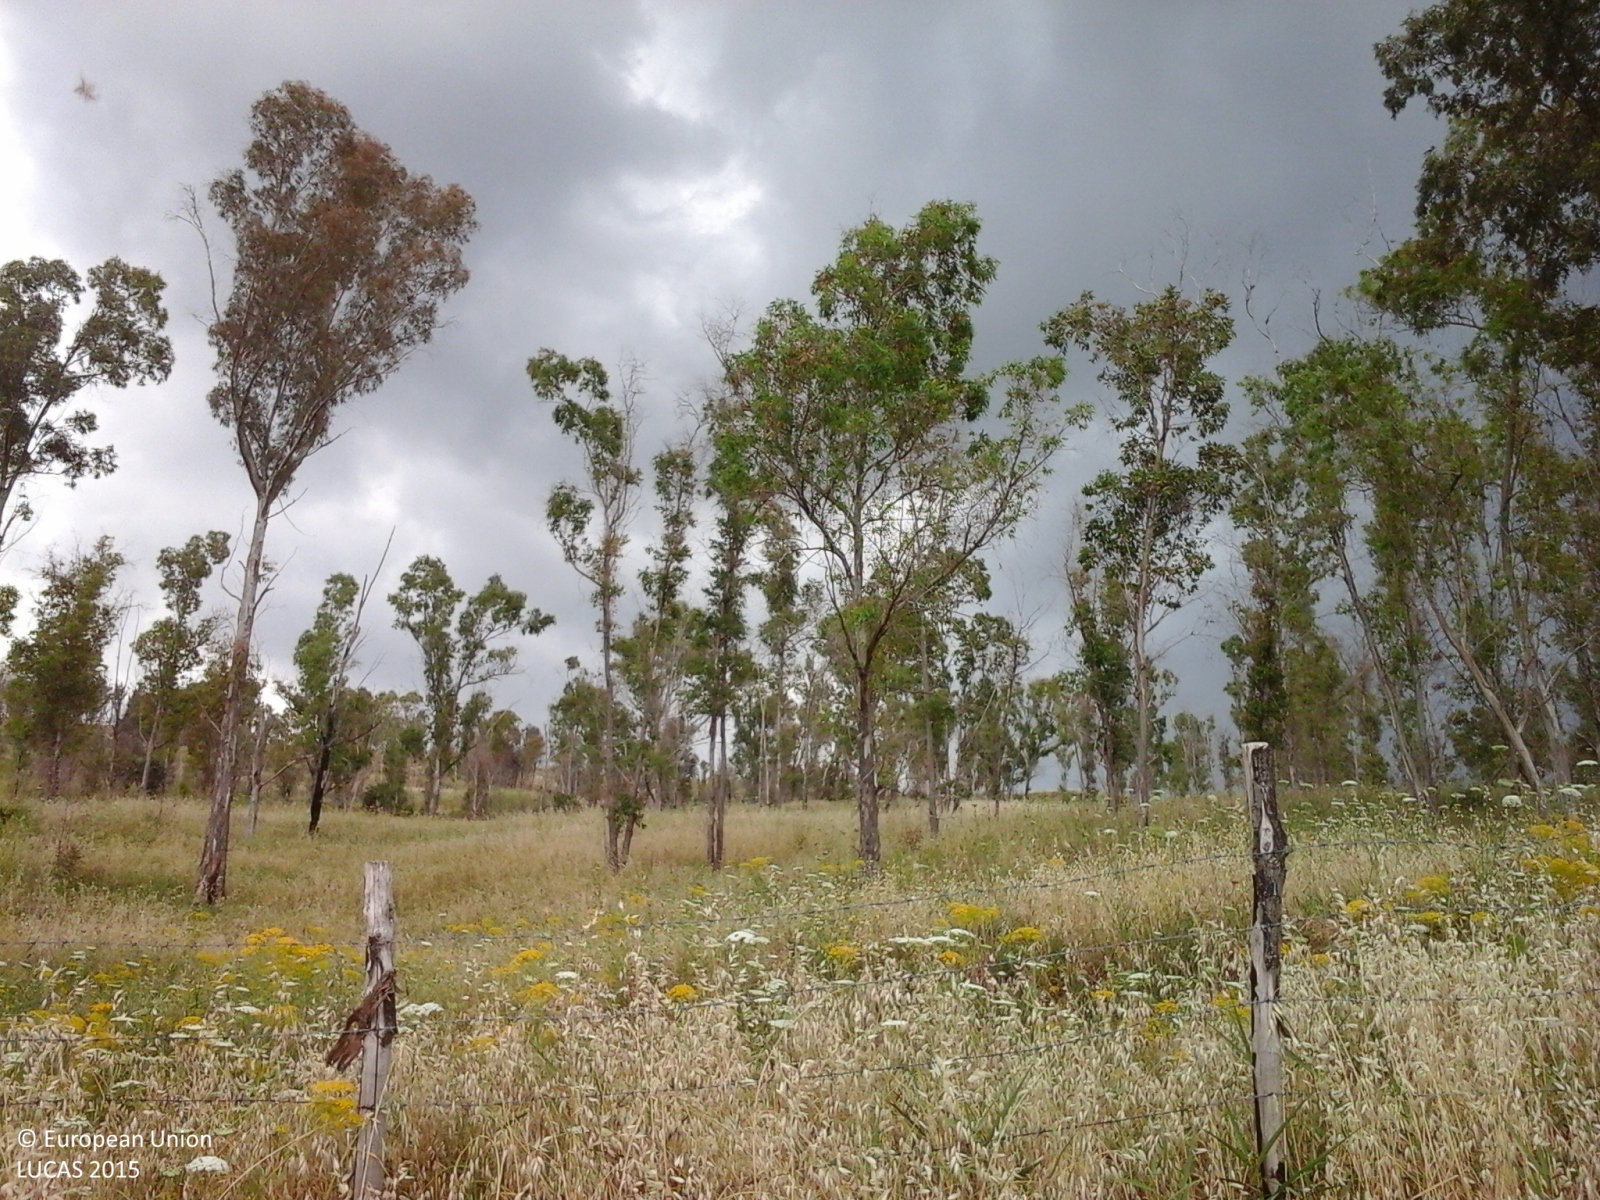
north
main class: Woodland
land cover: Broadleaved woodland
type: broadleaved evergreen forest
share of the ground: 25 - 50 %
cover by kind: herbaceous plants 60 %, broadleaved forest trees 40 %
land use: Forestry
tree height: > 5 m
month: June
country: IT
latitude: 37.5165
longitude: 13.5820
